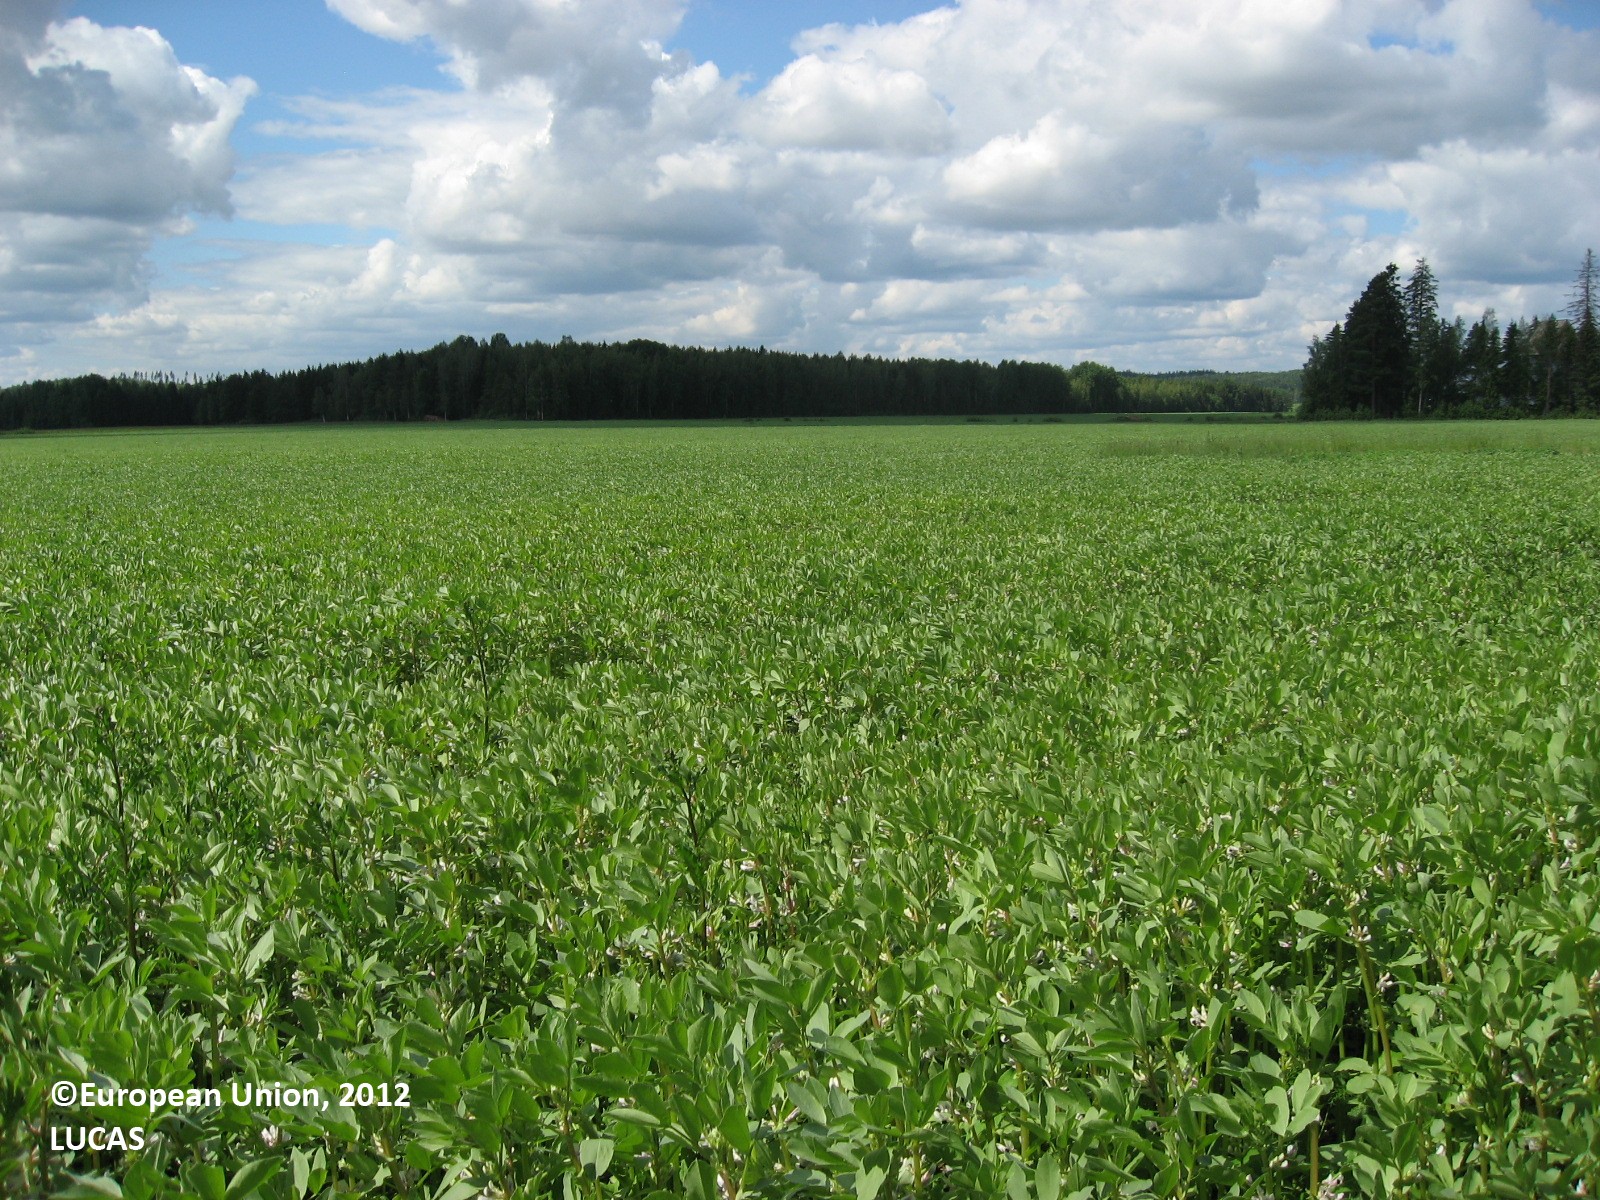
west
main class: Cropland
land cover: Dry pulses
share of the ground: > 75 %
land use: Agriculture (excluding fallow land and kitchen gardens)
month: July
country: FI
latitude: 60.7431
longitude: 26.2334
